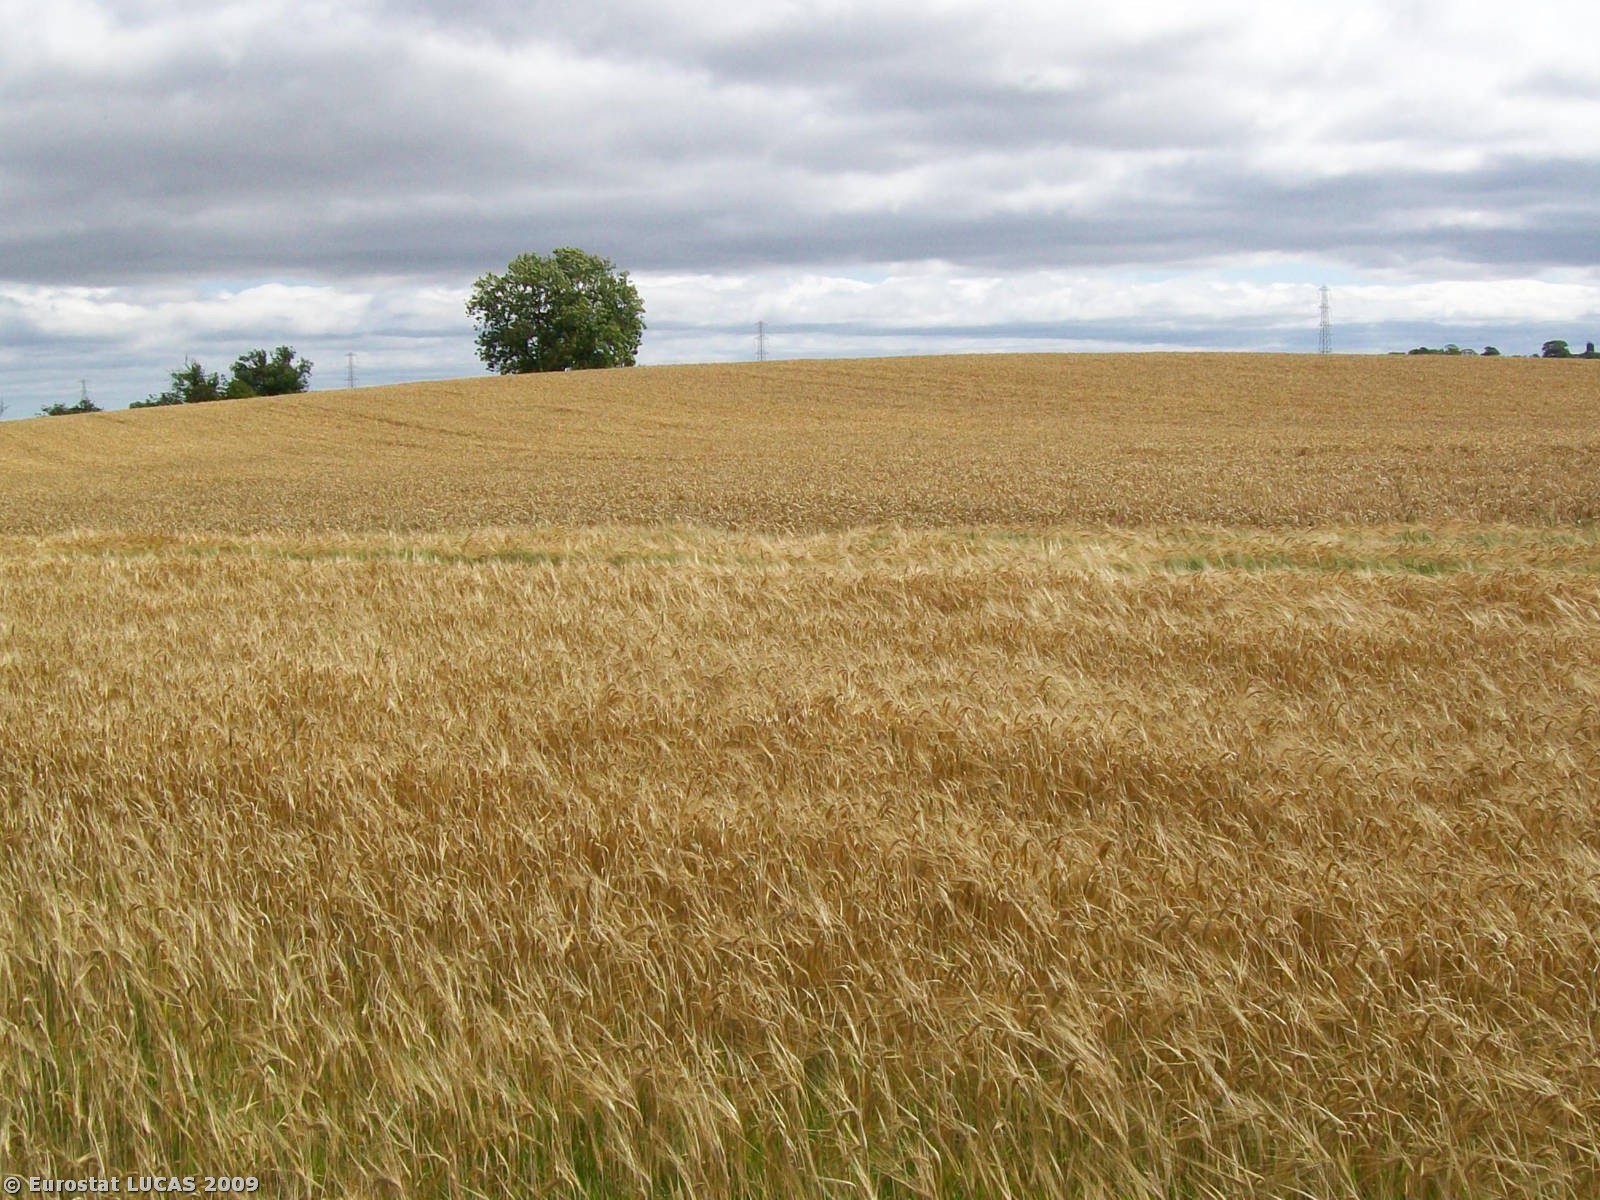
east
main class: Cropland
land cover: Common wheat
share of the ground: > 75 %
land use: Agriculture (excluding fallow land and kitchen gardens)
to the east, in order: Common wheat; Barley; Grassland with sparse tree/shrub cover; Oats; Grassland without tree/shrub cover
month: August
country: GB
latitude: 55.0817
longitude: -1.7523
